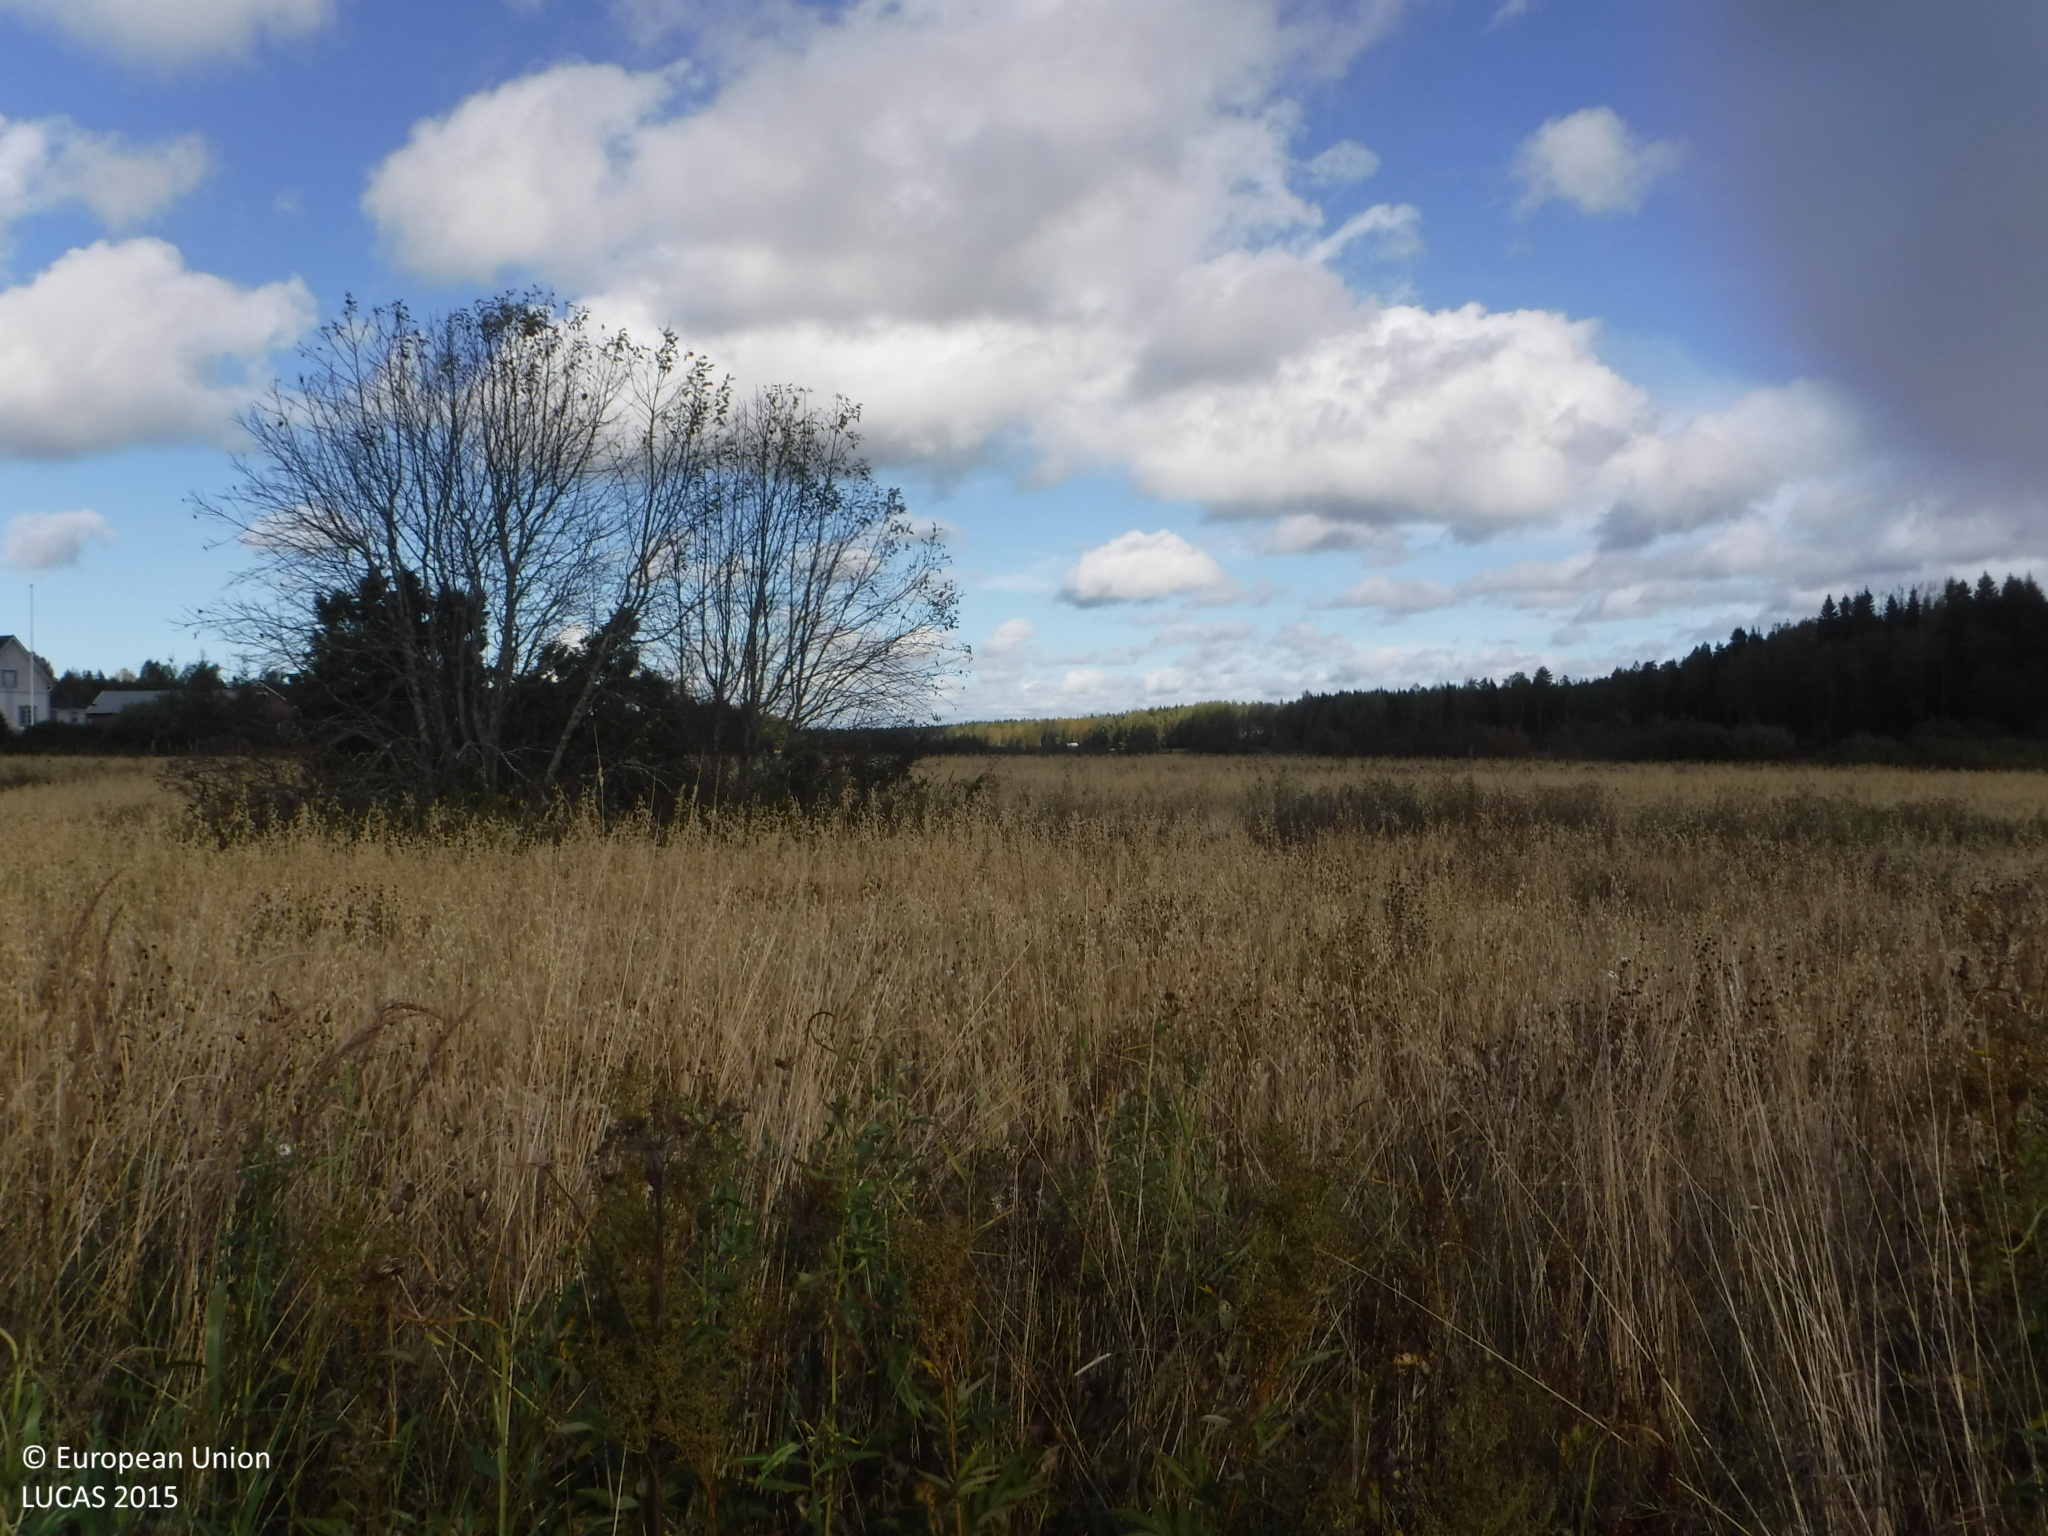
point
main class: Cropland
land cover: Oats
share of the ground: > 75 %
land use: Agriculture (excluding fallow land and kitchen gardens)
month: September
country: FI
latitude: 62.1460
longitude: 21.5774
